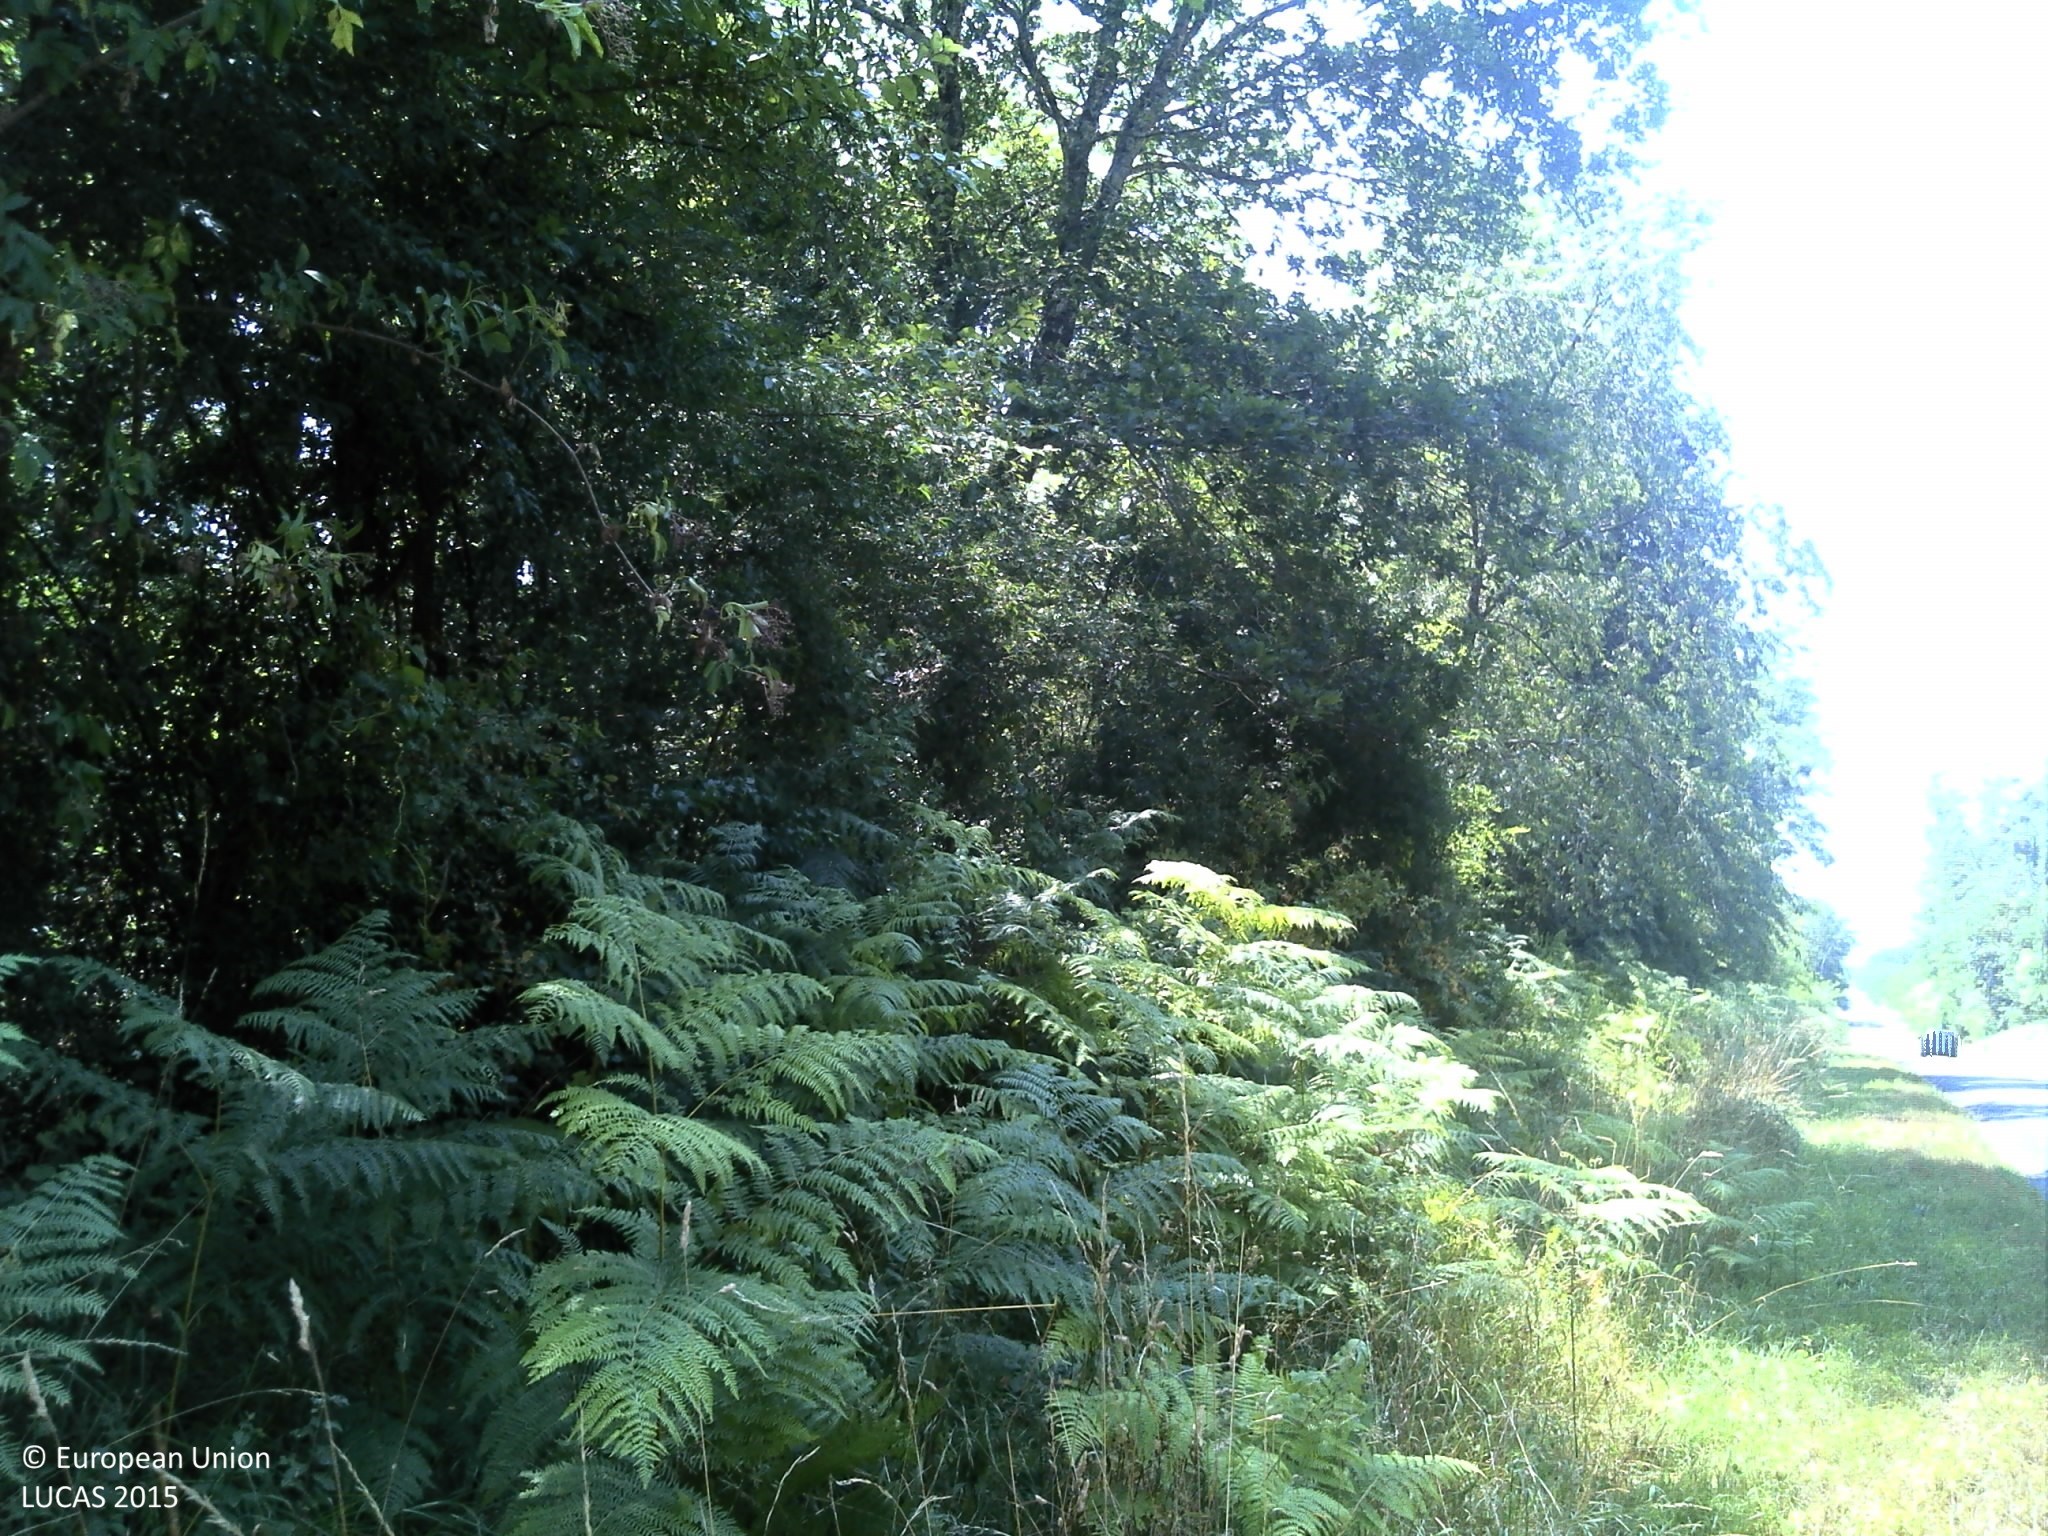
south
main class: Woodland
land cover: Broadleaved woodland
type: mesophytic deciduous forest
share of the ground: > 75 %
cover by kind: broadleaved forest trees 80 %, shrubs 10 %, coniferous forest trees 5 %, herbaceous plants 5 %
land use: Forestry
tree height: > 5 m
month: July
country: FR
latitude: 44.6450
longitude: -0.3923
